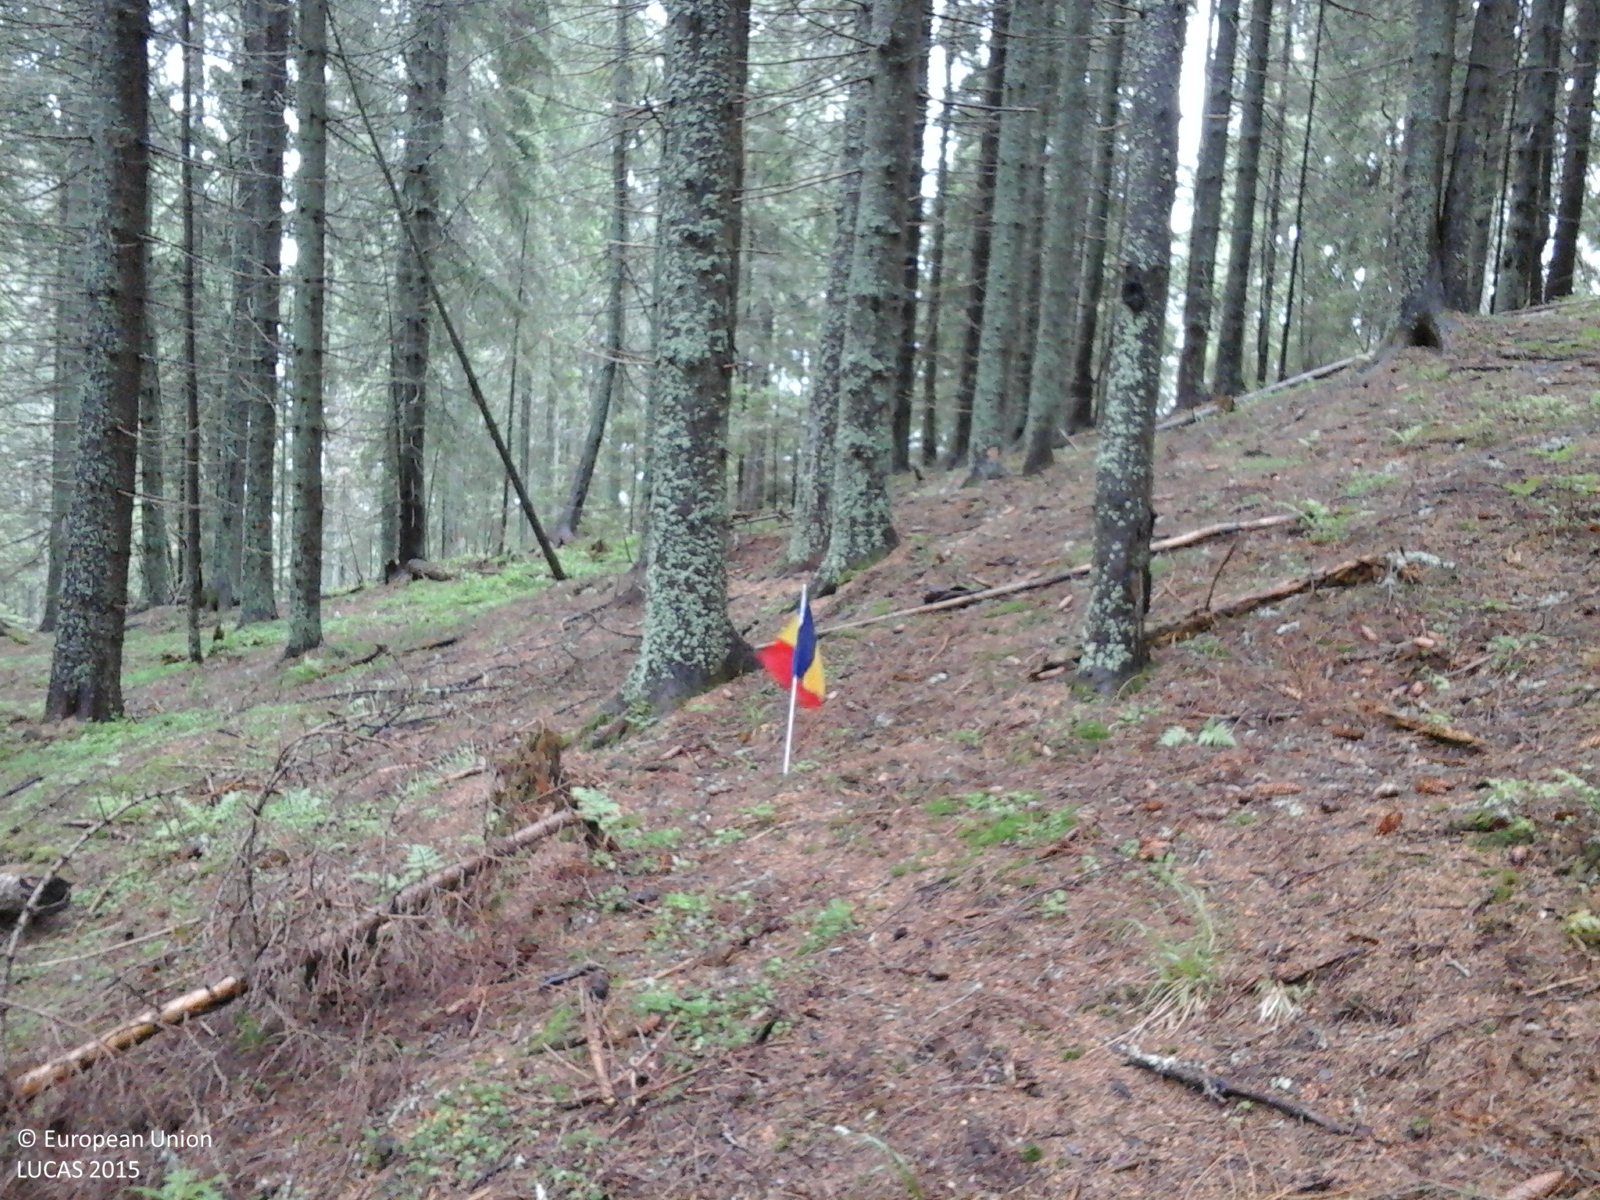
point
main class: Woodland
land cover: Spruce dominated coniferous woodland
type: alpine coniferous forest
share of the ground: > 75 %
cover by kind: coniferous forest trees 100 %
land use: Forestry
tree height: > 5 m
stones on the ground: < 10 %
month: June
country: RO
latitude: 47.6481
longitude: 25.3838
